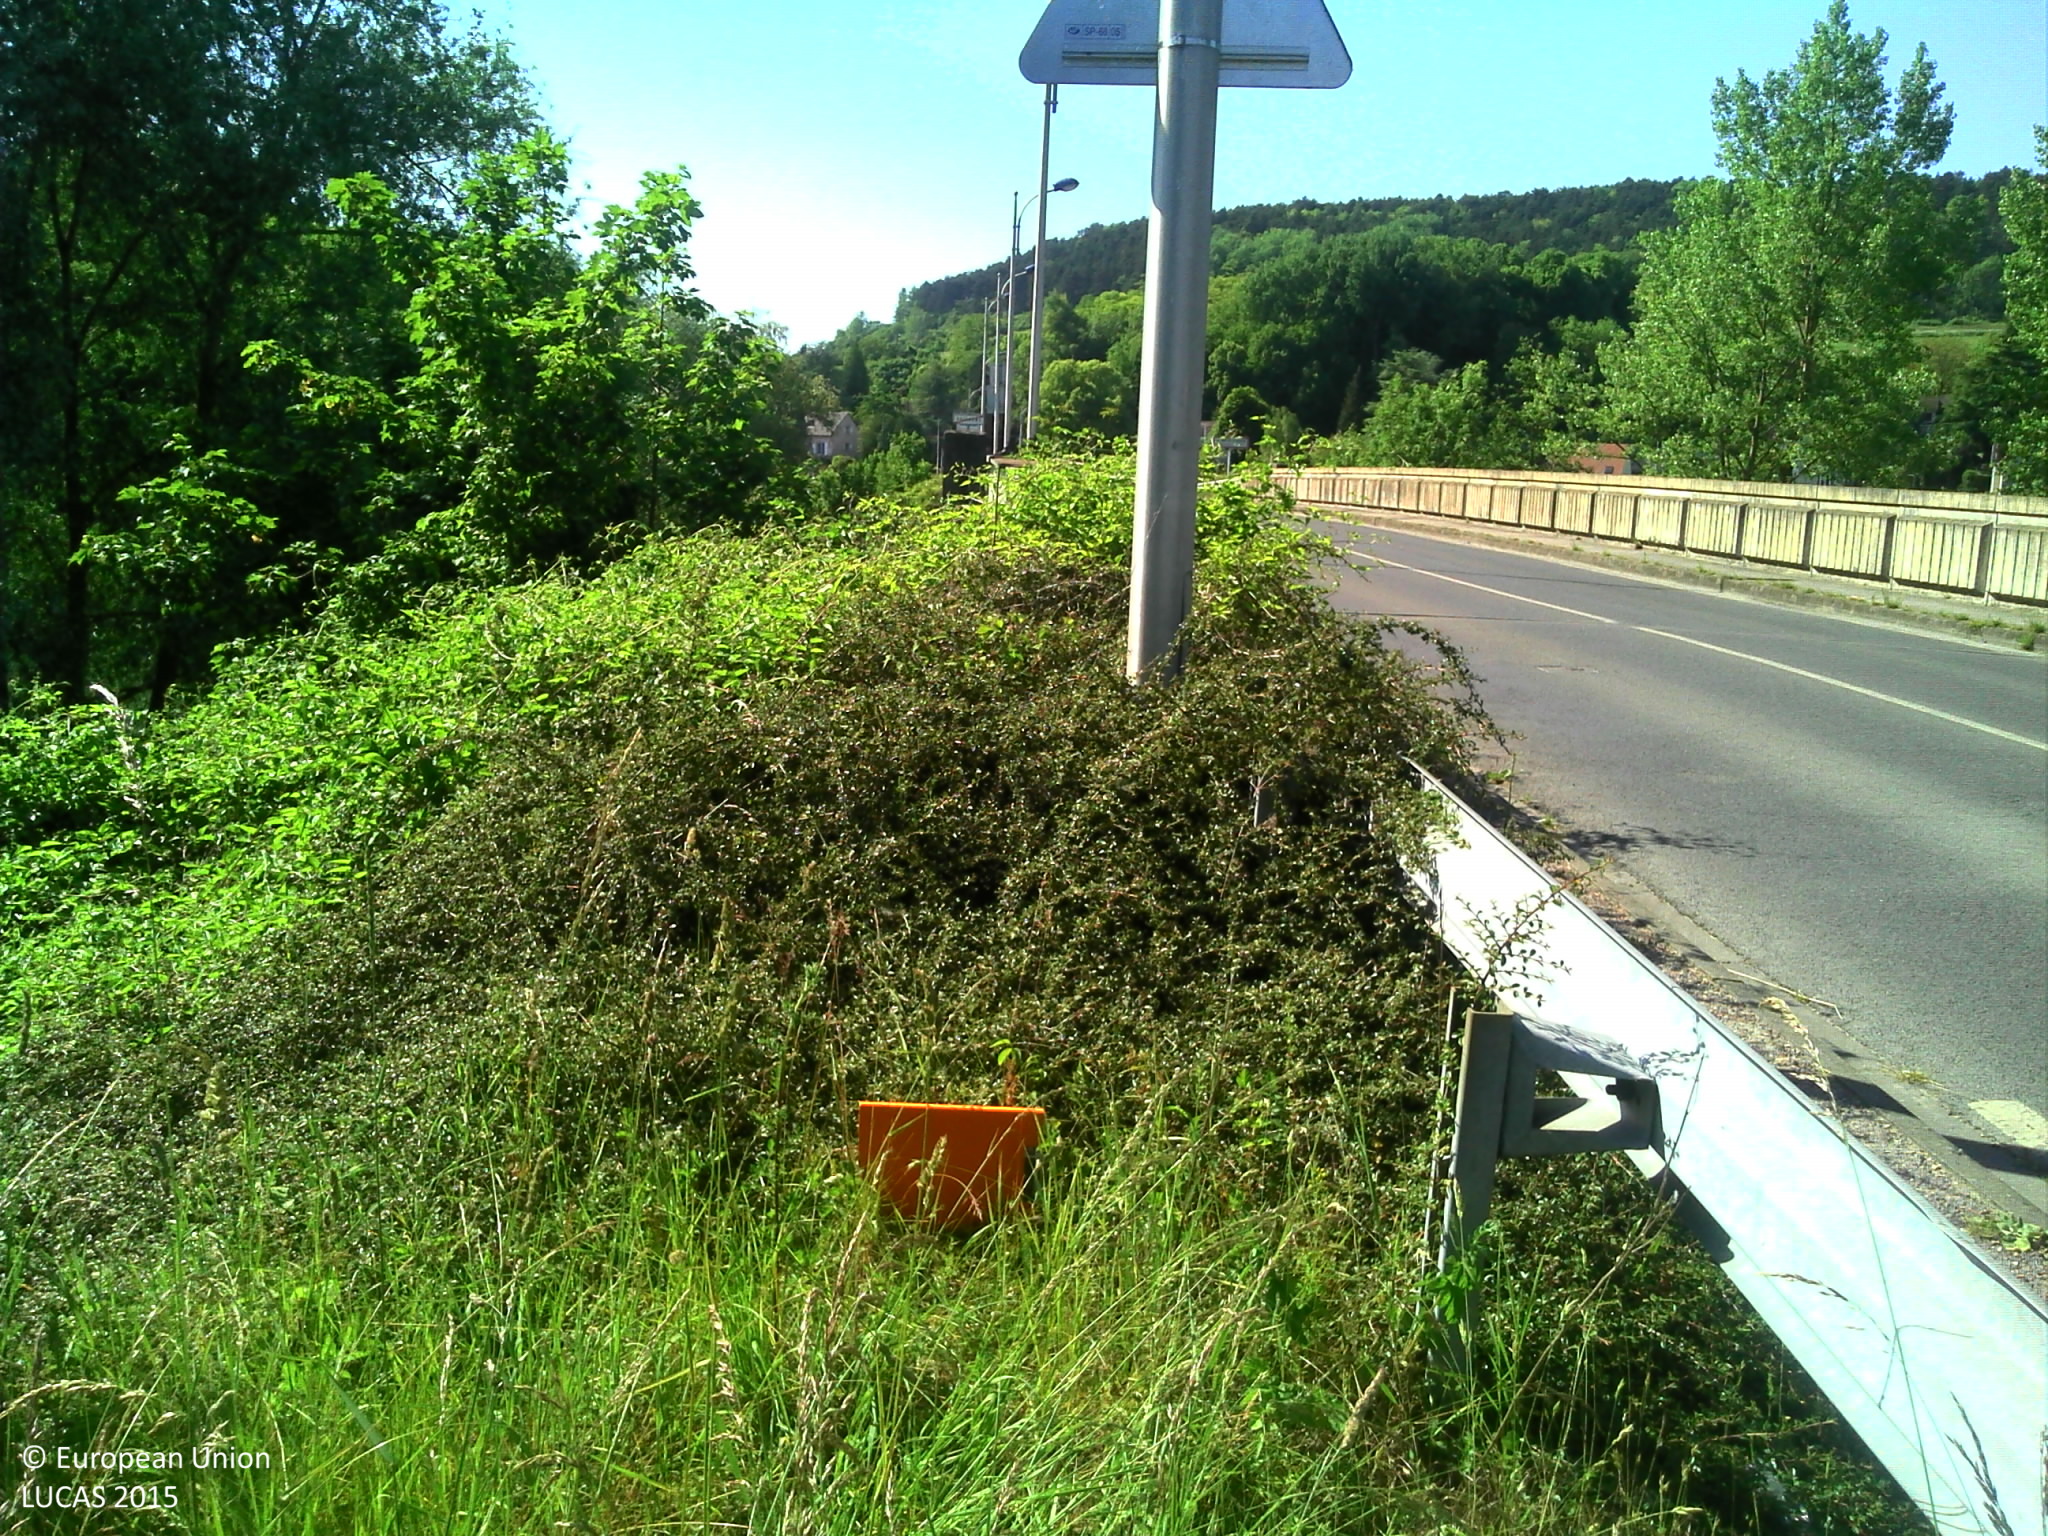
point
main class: Grassland
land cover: Spontaneously vegetated surfaces
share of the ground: > 75 %
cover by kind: herbaceous plants 95 %, shrubs 5 %
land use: Semi-natural and natural areas not in use
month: June
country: FR
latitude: 49.3922
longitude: 3.3099
